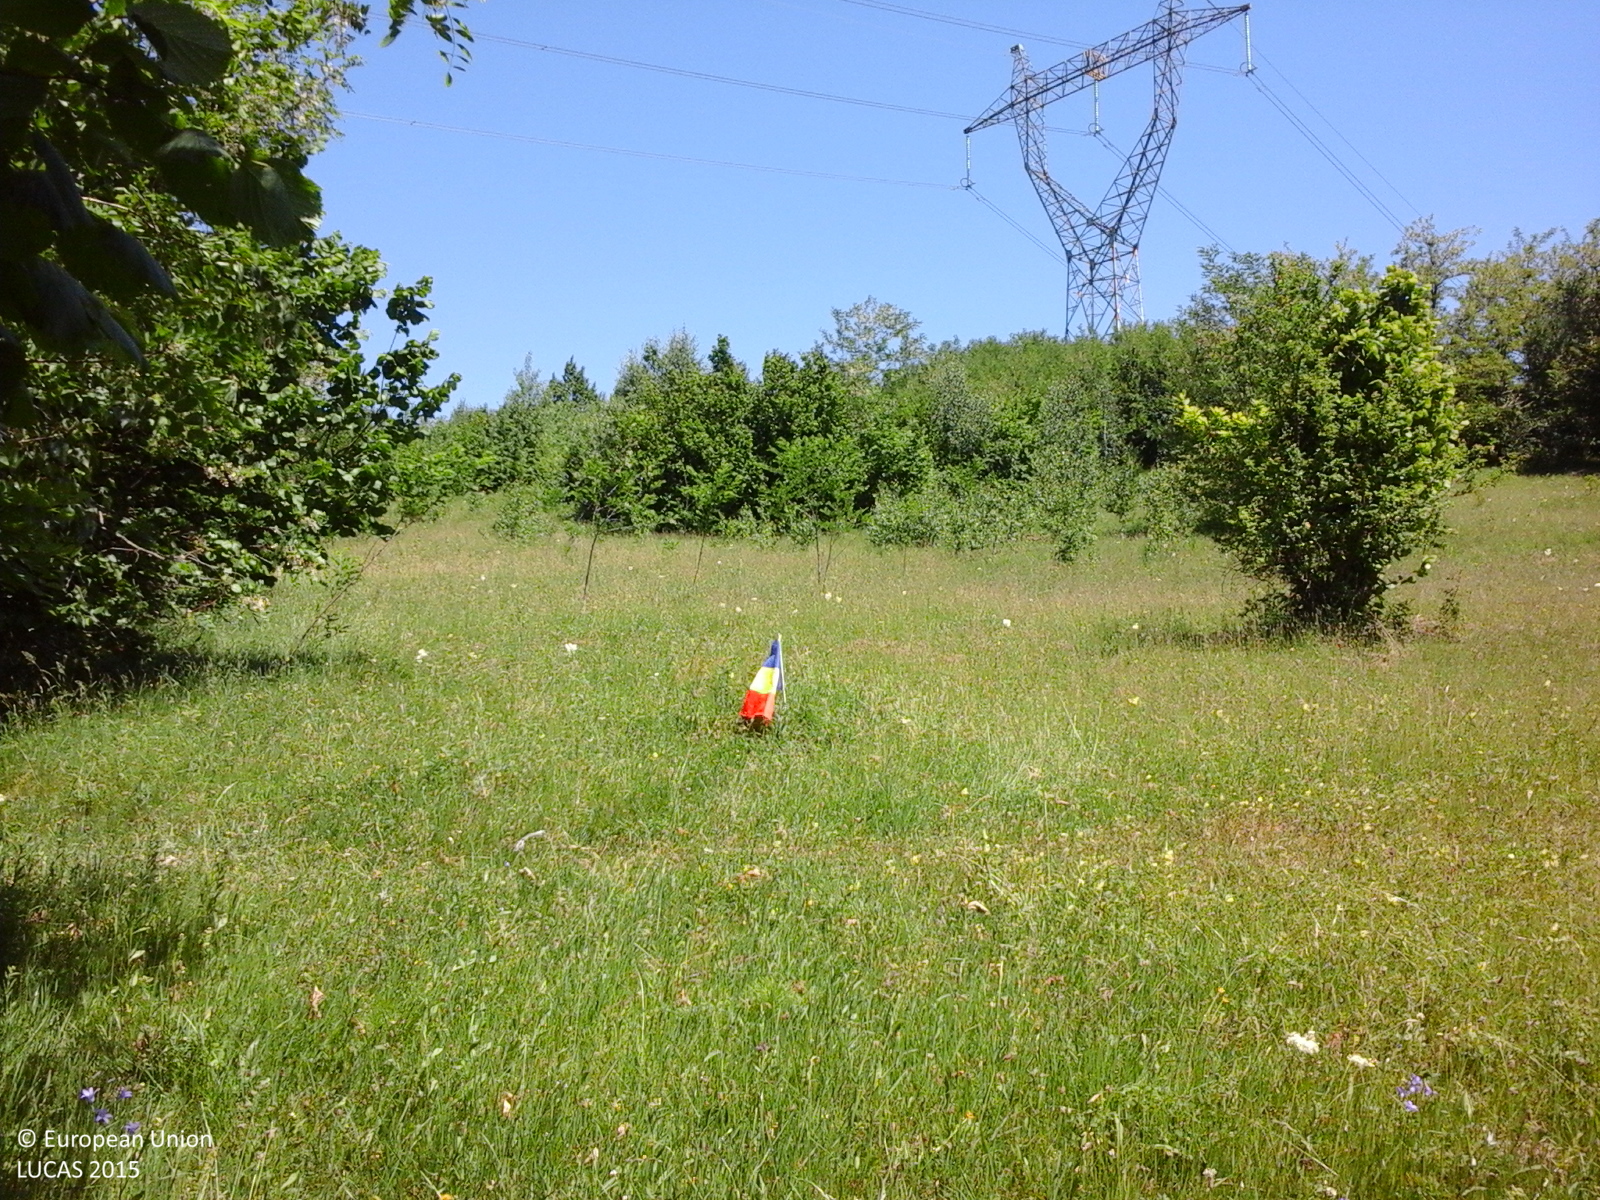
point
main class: Grassland
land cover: Grassland with sparse tree/shrub cover
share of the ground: > 75 %
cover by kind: herbaceous plants 85 %, shrubs 10 %, broadleaved forest trees 5 %
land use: Agriculture (excluding fallow land and kitchen gardens)
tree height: > 5 m
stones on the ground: < 10 %
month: June
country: RO
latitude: 45.2113
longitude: 25.7528
